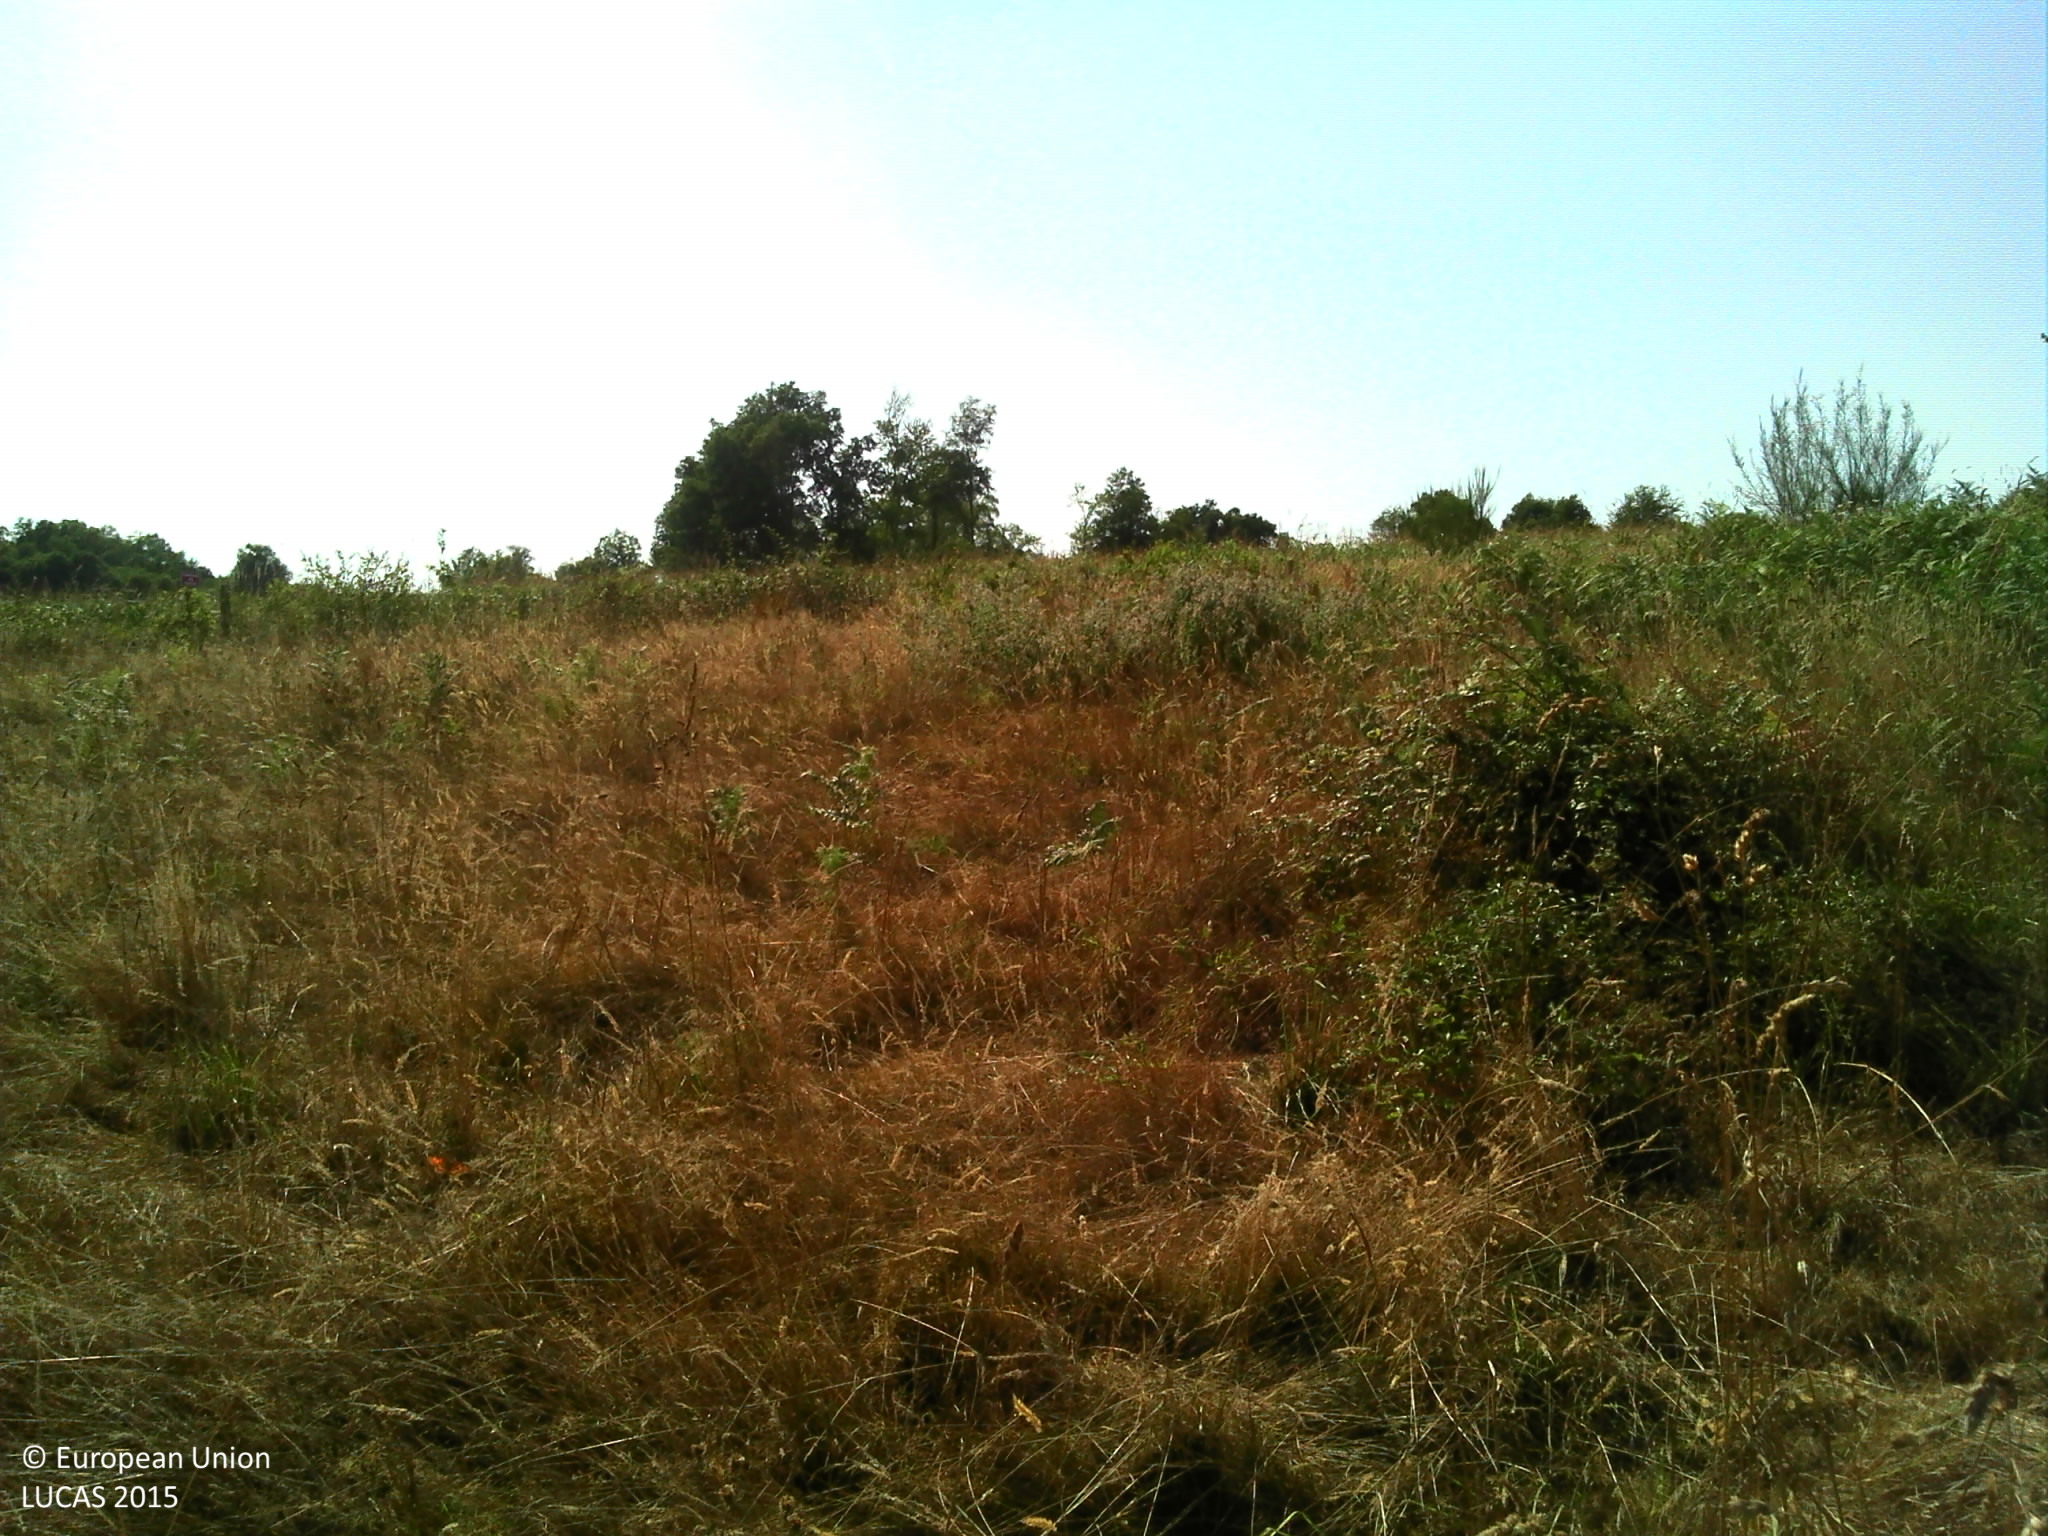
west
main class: Grassland
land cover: Grassland without tree/shrub cover
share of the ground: > 75 %
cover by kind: herbaceous plants 95 %, lichens and mosses 5 %
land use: Agriculture (excluding fallow land and kitchen gardens)
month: August
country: FR
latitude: 45.4123
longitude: 1.0339
